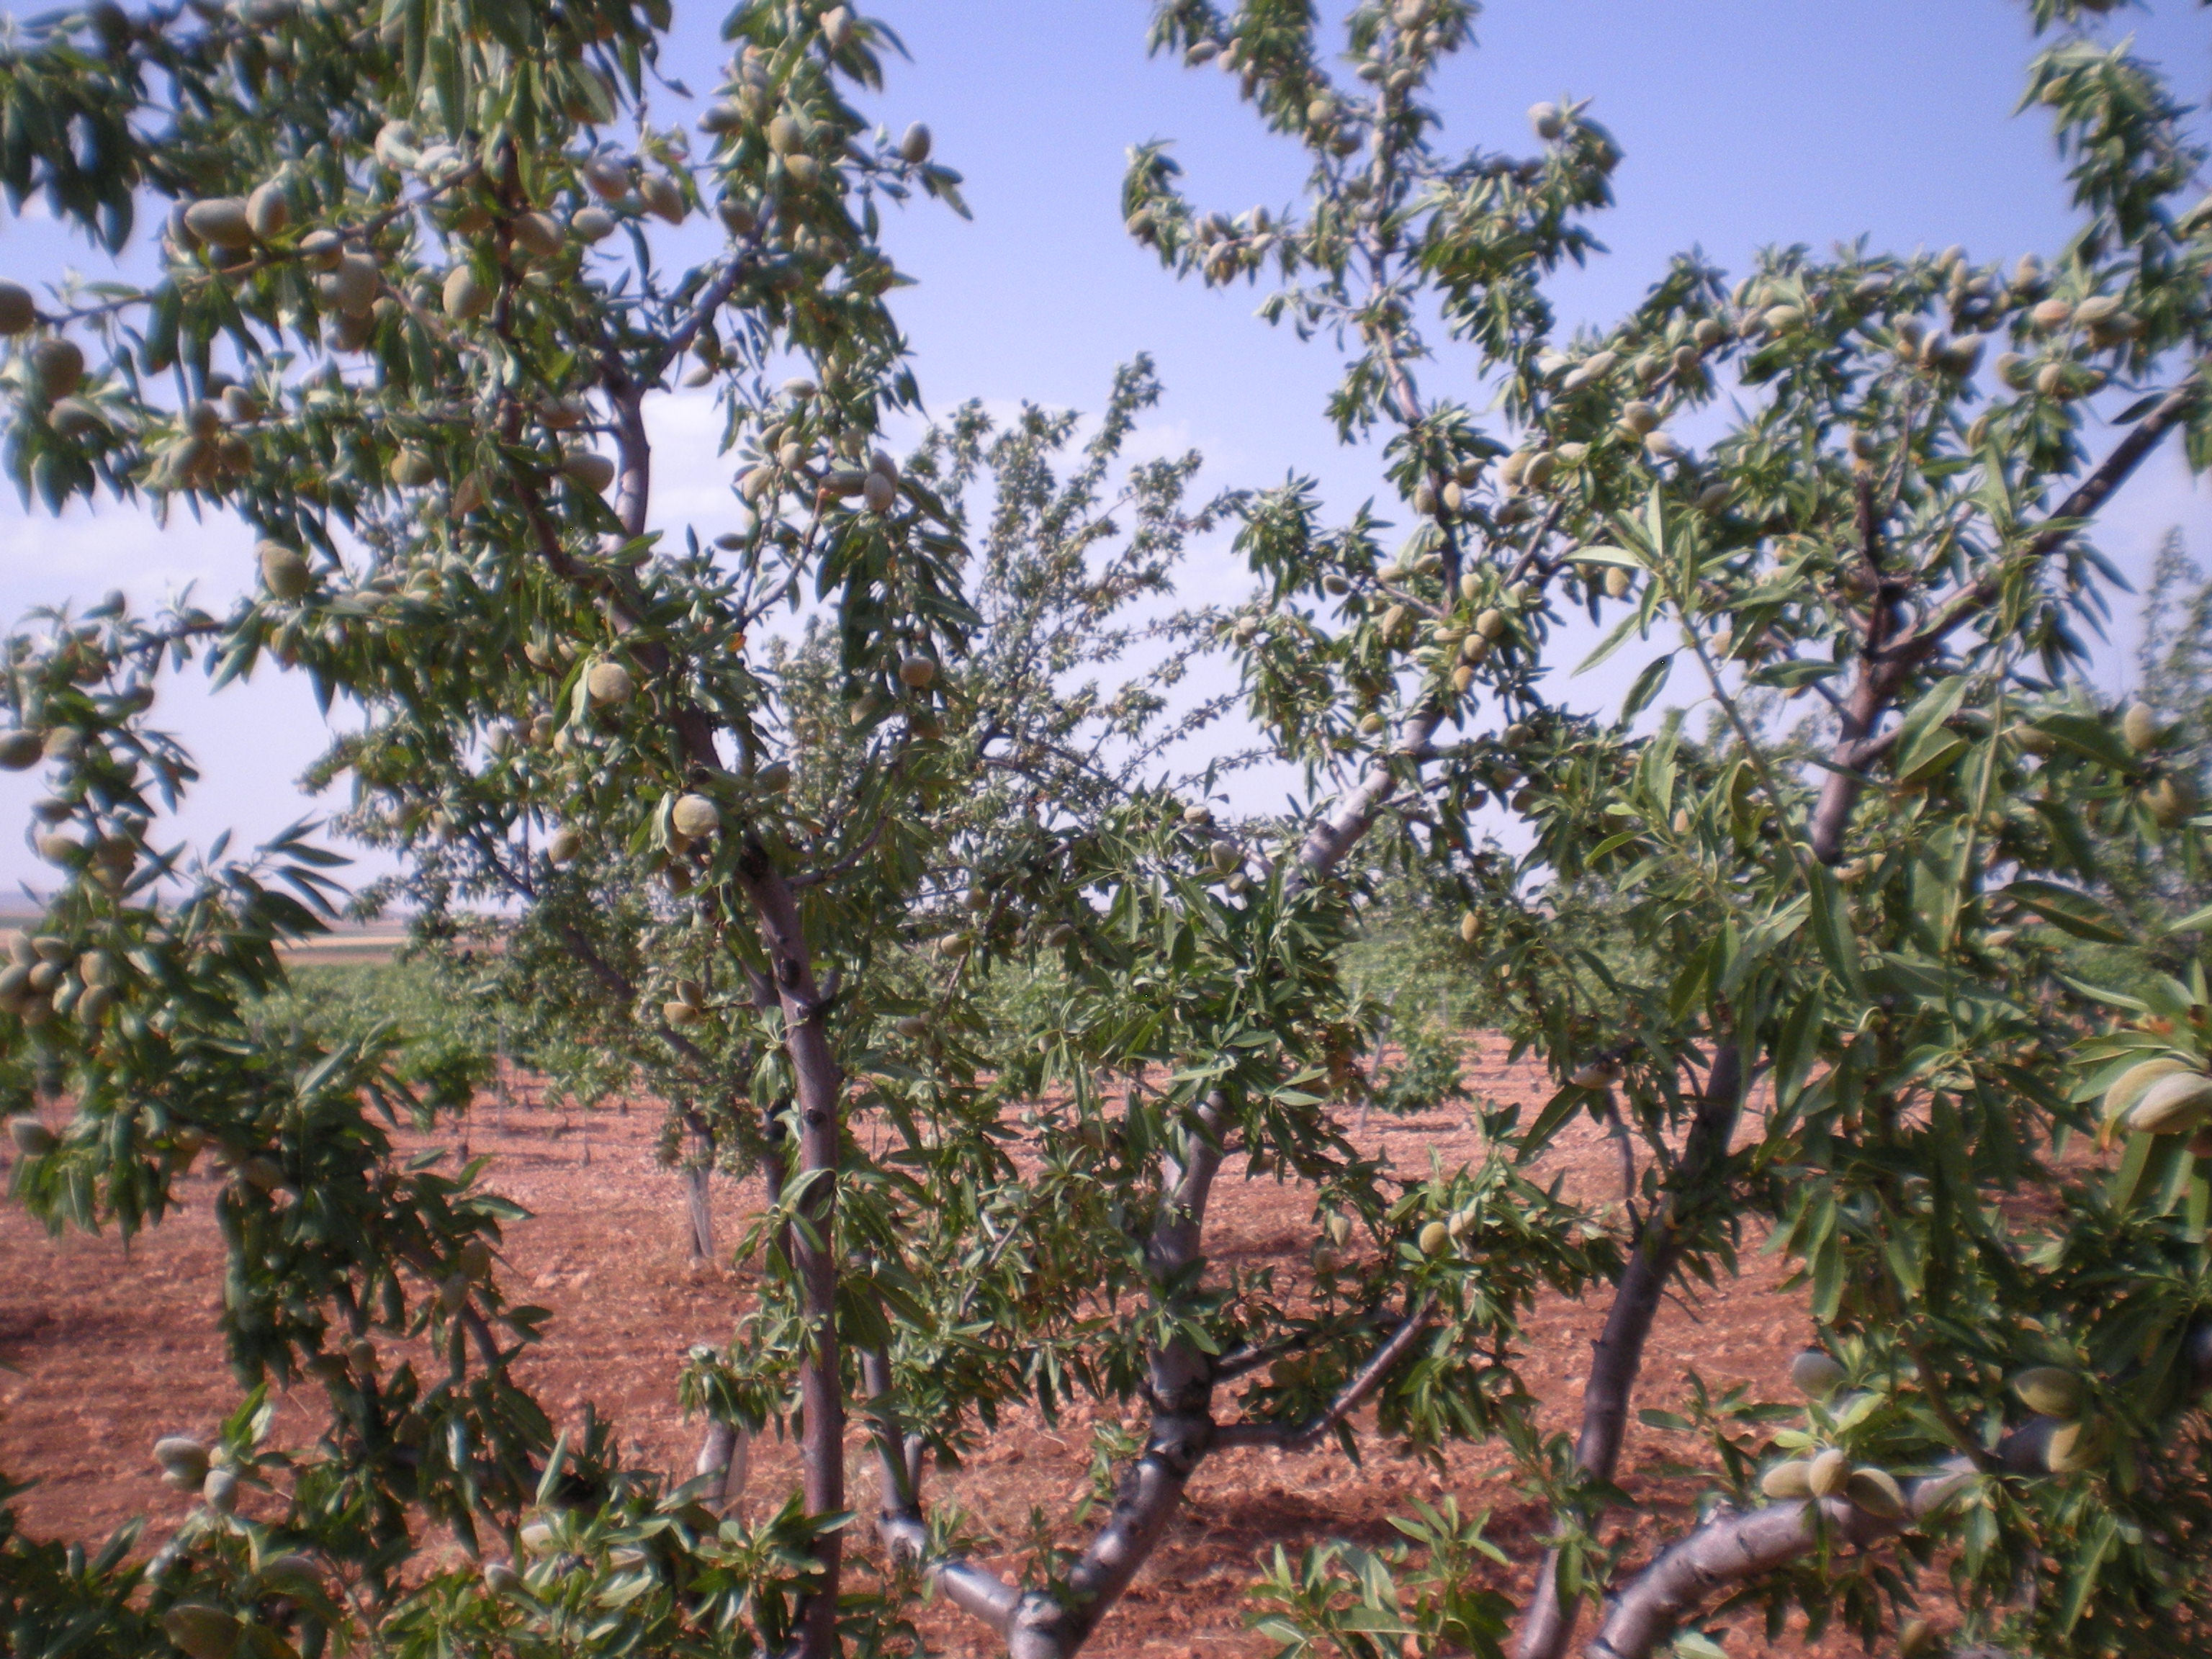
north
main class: Cropland
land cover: Nuts trees
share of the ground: 25 - 50 %
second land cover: Other bare soil
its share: > 75 %
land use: Agriculture (excluding fallow land and kitchen gardens)
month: June
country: ES
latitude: 39.5346
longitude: -3.3431
